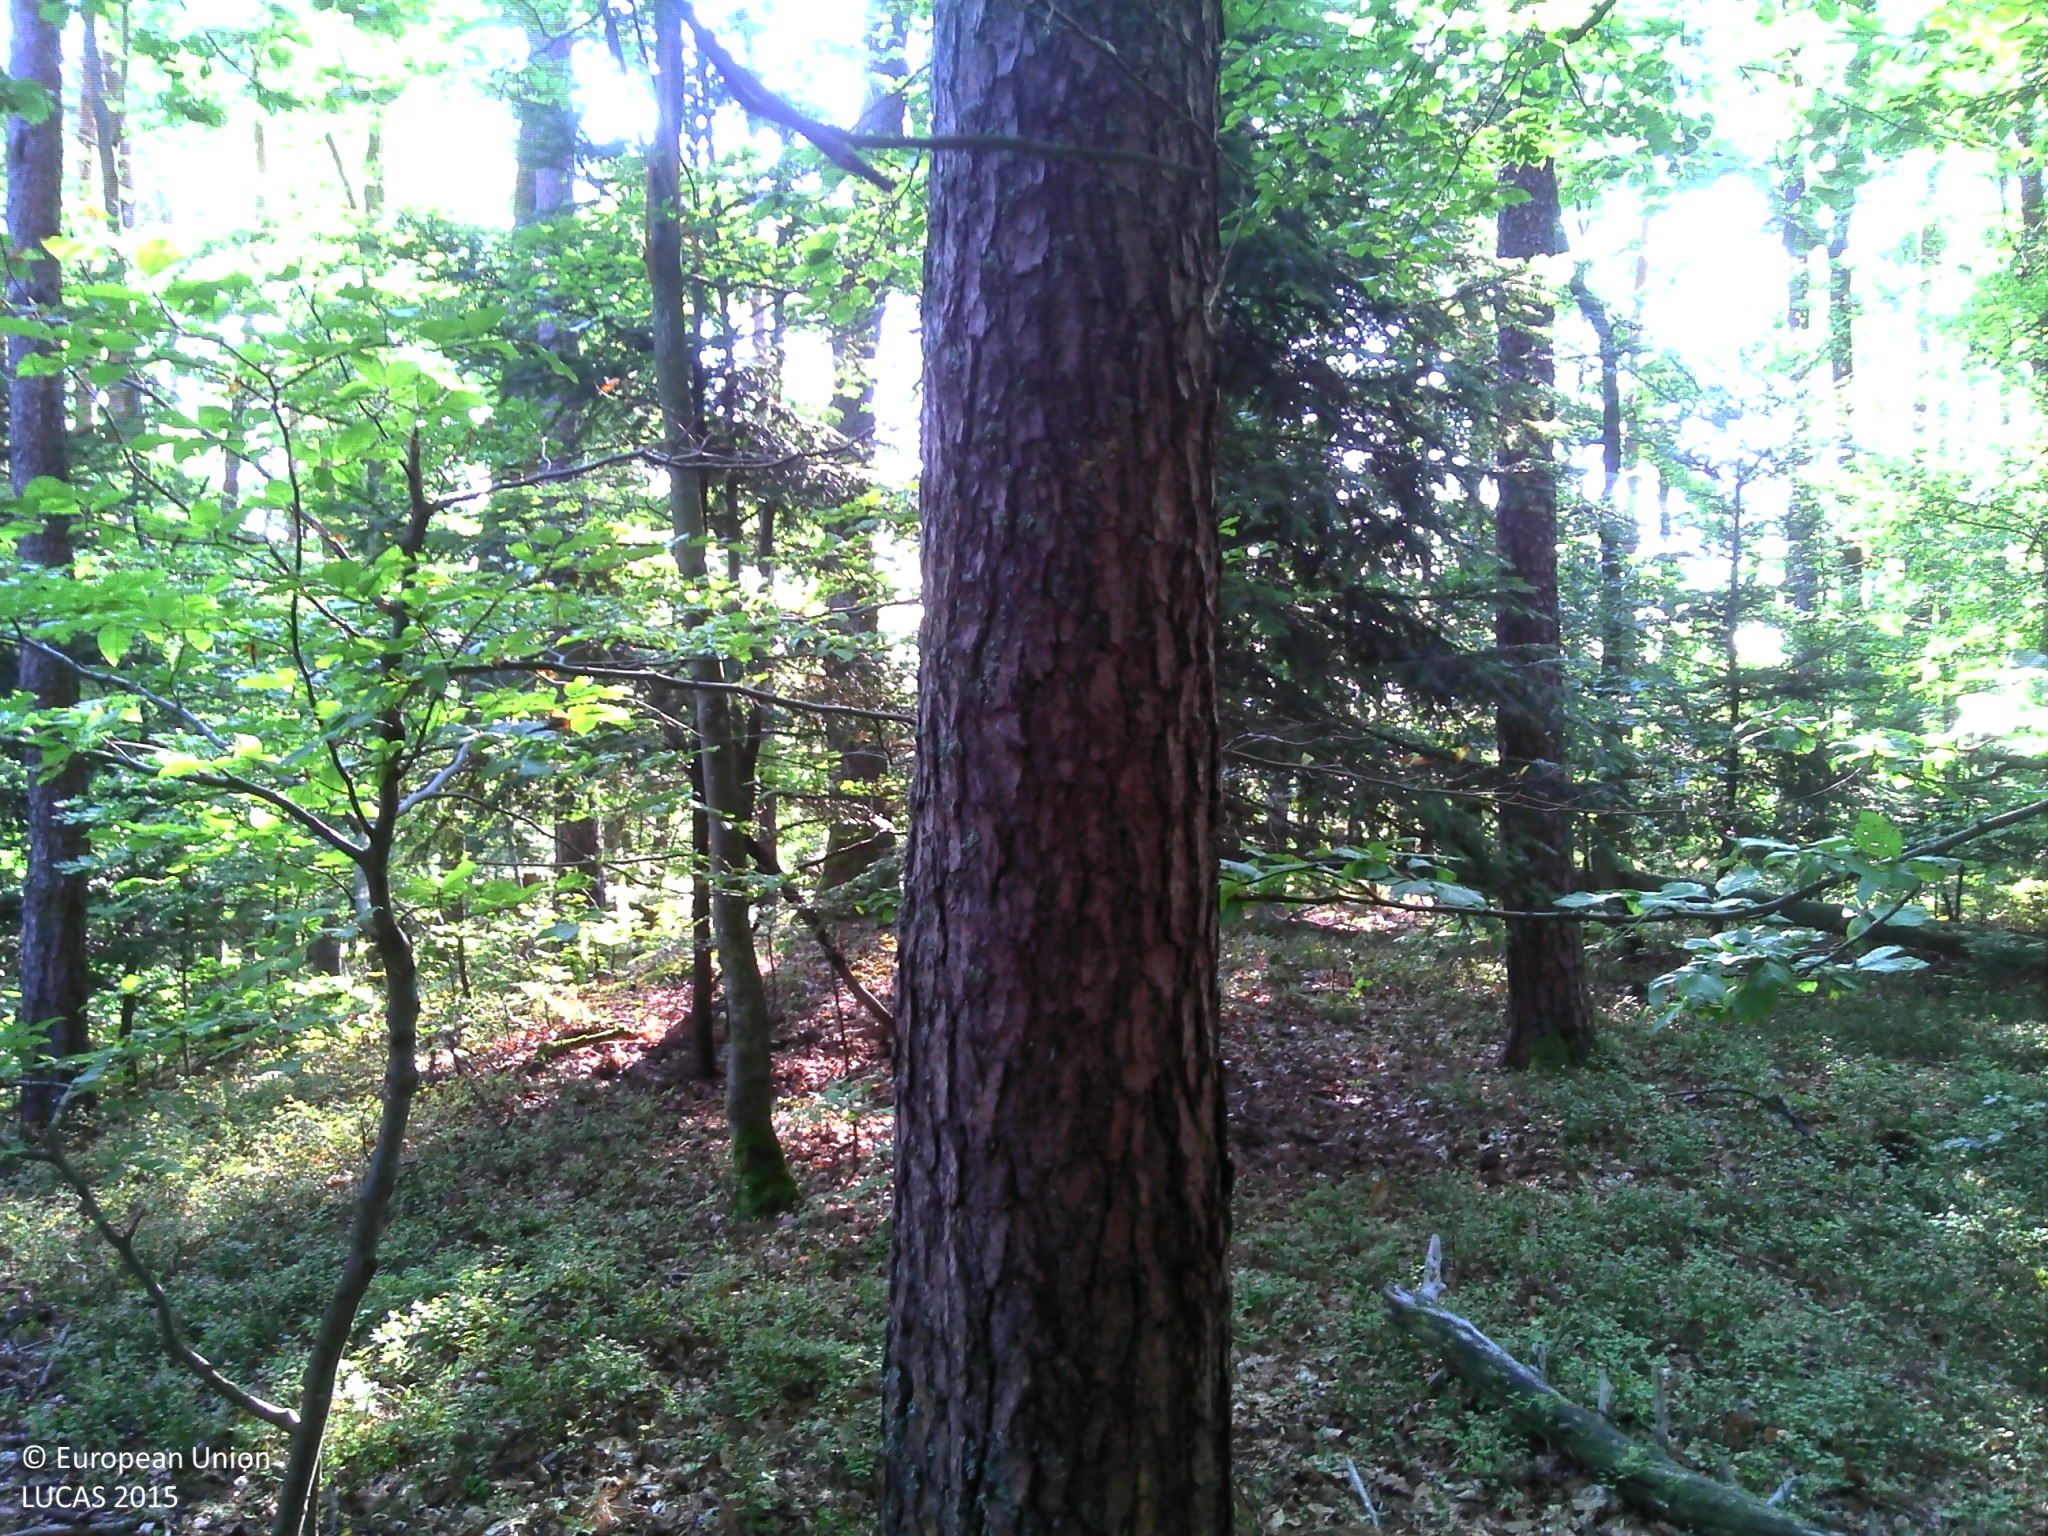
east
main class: Woodland
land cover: Pine dominated mixed woodland
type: hemiboreal forest and nemoral coniferous forest and mixed broadleaved-coniferous forest
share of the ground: > 75 %
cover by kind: broadleaved forest trees 55 %, coniferous forest trees 40 %, herbaceous plants 5 %
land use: Forestry
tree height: > 5 m
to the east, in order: Pine dominated mixed woodland; Tracks; Pine dominated mixed woodland; Spruce dominated coniferous woodland; Tracks; Spruce dominated coniferous woodland
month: August
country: FR
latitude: 48.3369
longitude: 7.3973
